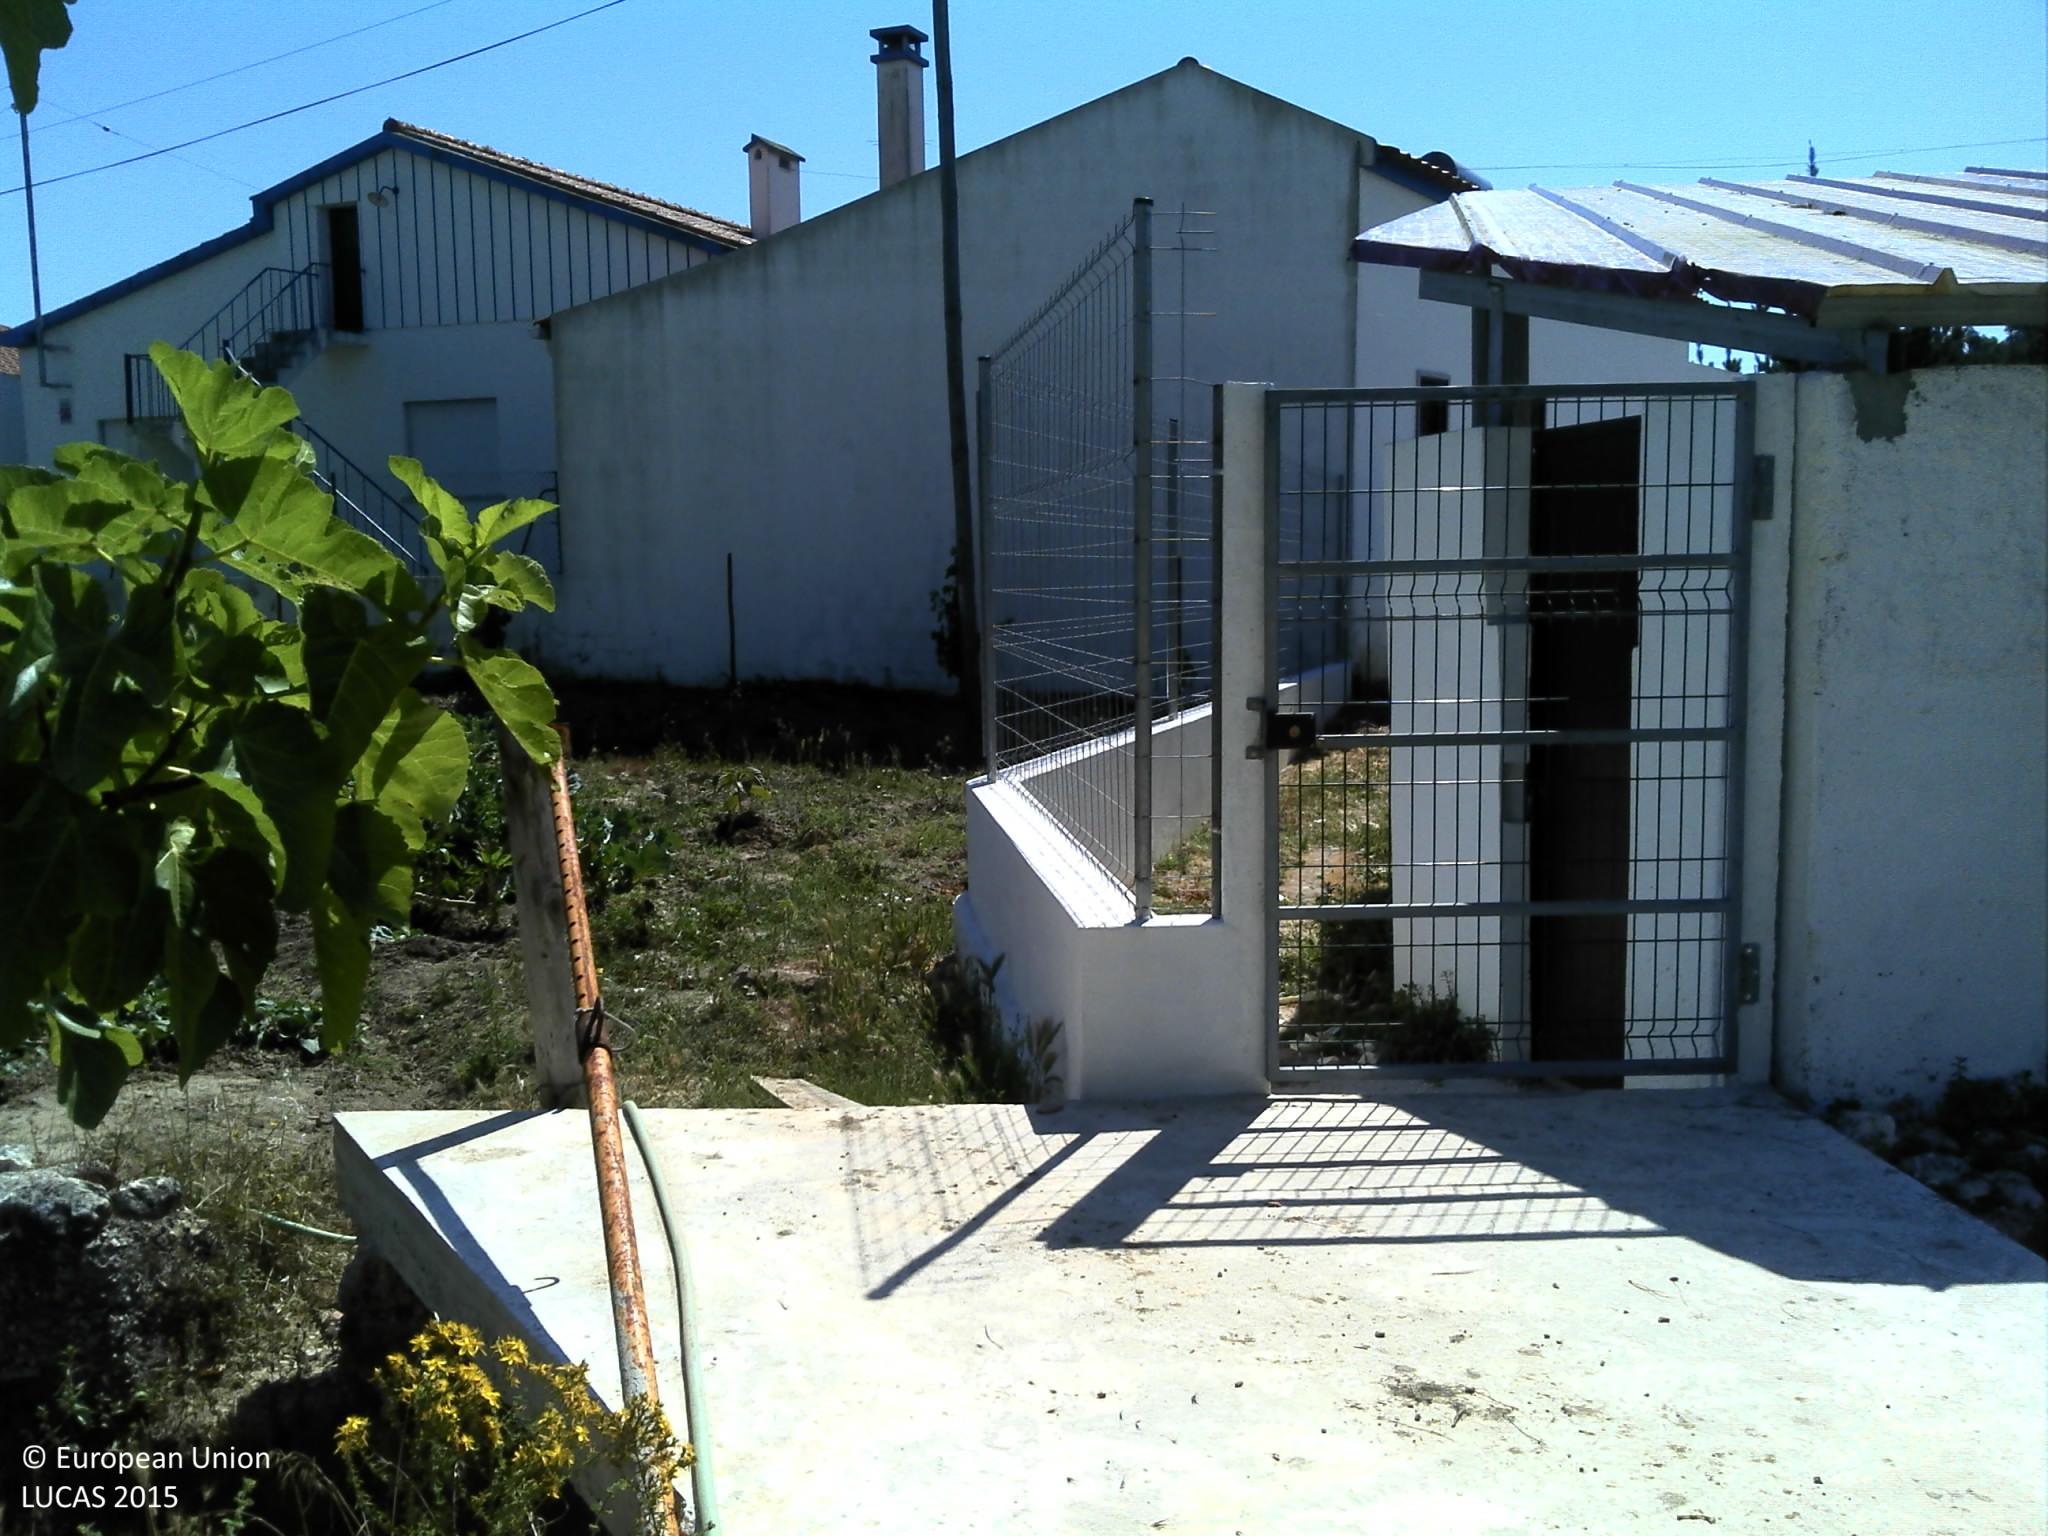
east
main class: Cropland
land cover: Other fruit trees and berries
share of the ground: 25 - 50 %
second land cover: Grassland without tree/shrub cover
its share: 50 - 75 %
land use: Kitchen garden
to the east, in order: Other fruit trees and berries; Grassland without tree/shrub cover; Rivers and streams; Artificial constructions in urban areas; Pine dominated coniferous woodland; Fences; Grassland without tree/shrub cover; Maize; Other fresh vegetables; Electric lines; Other fresh vegetables; Ditches and canals; Other fresh vegetables; Ditches and canals; Other fresh vegetables
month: June
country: PT
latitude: 39.1408
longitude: -9.2343
